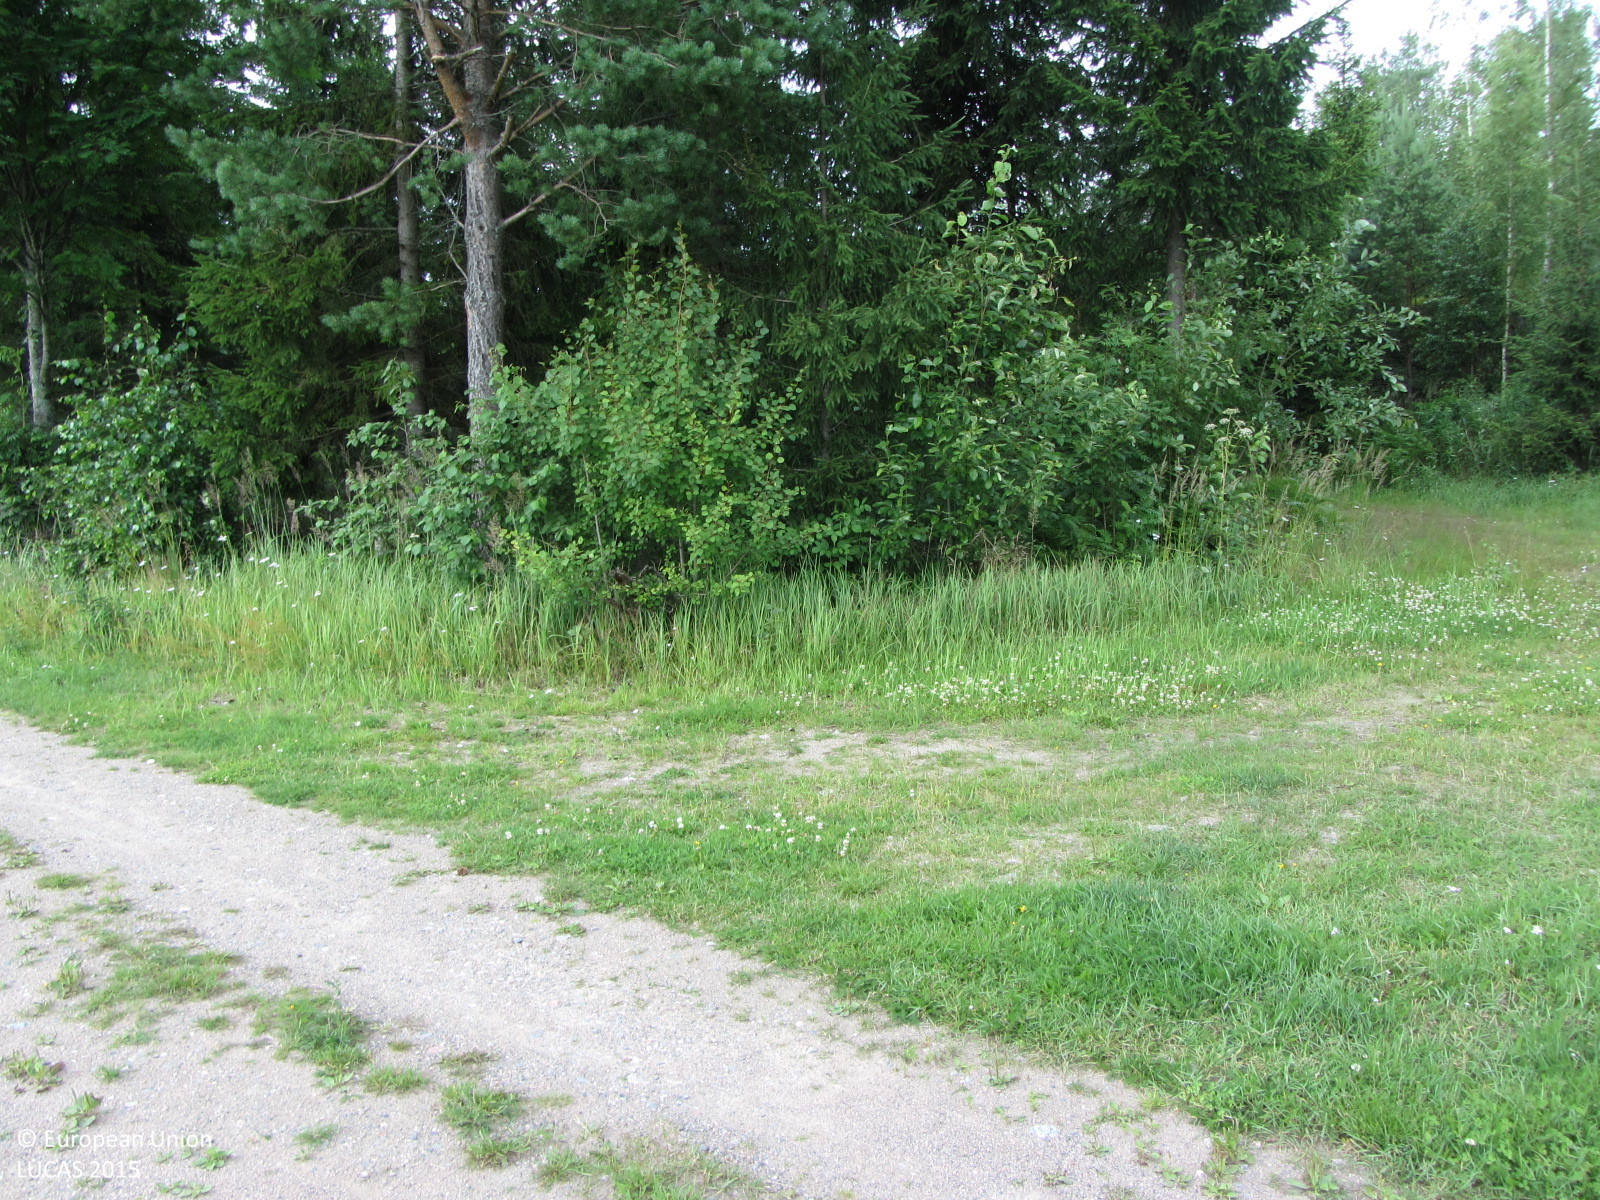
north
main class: Cropland
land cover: Barley
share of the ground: > 75 %
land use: Agriculture (excluding fallow land and kitchen gardens)
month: July
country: FI
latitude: 60.6729
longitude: 24.5097
